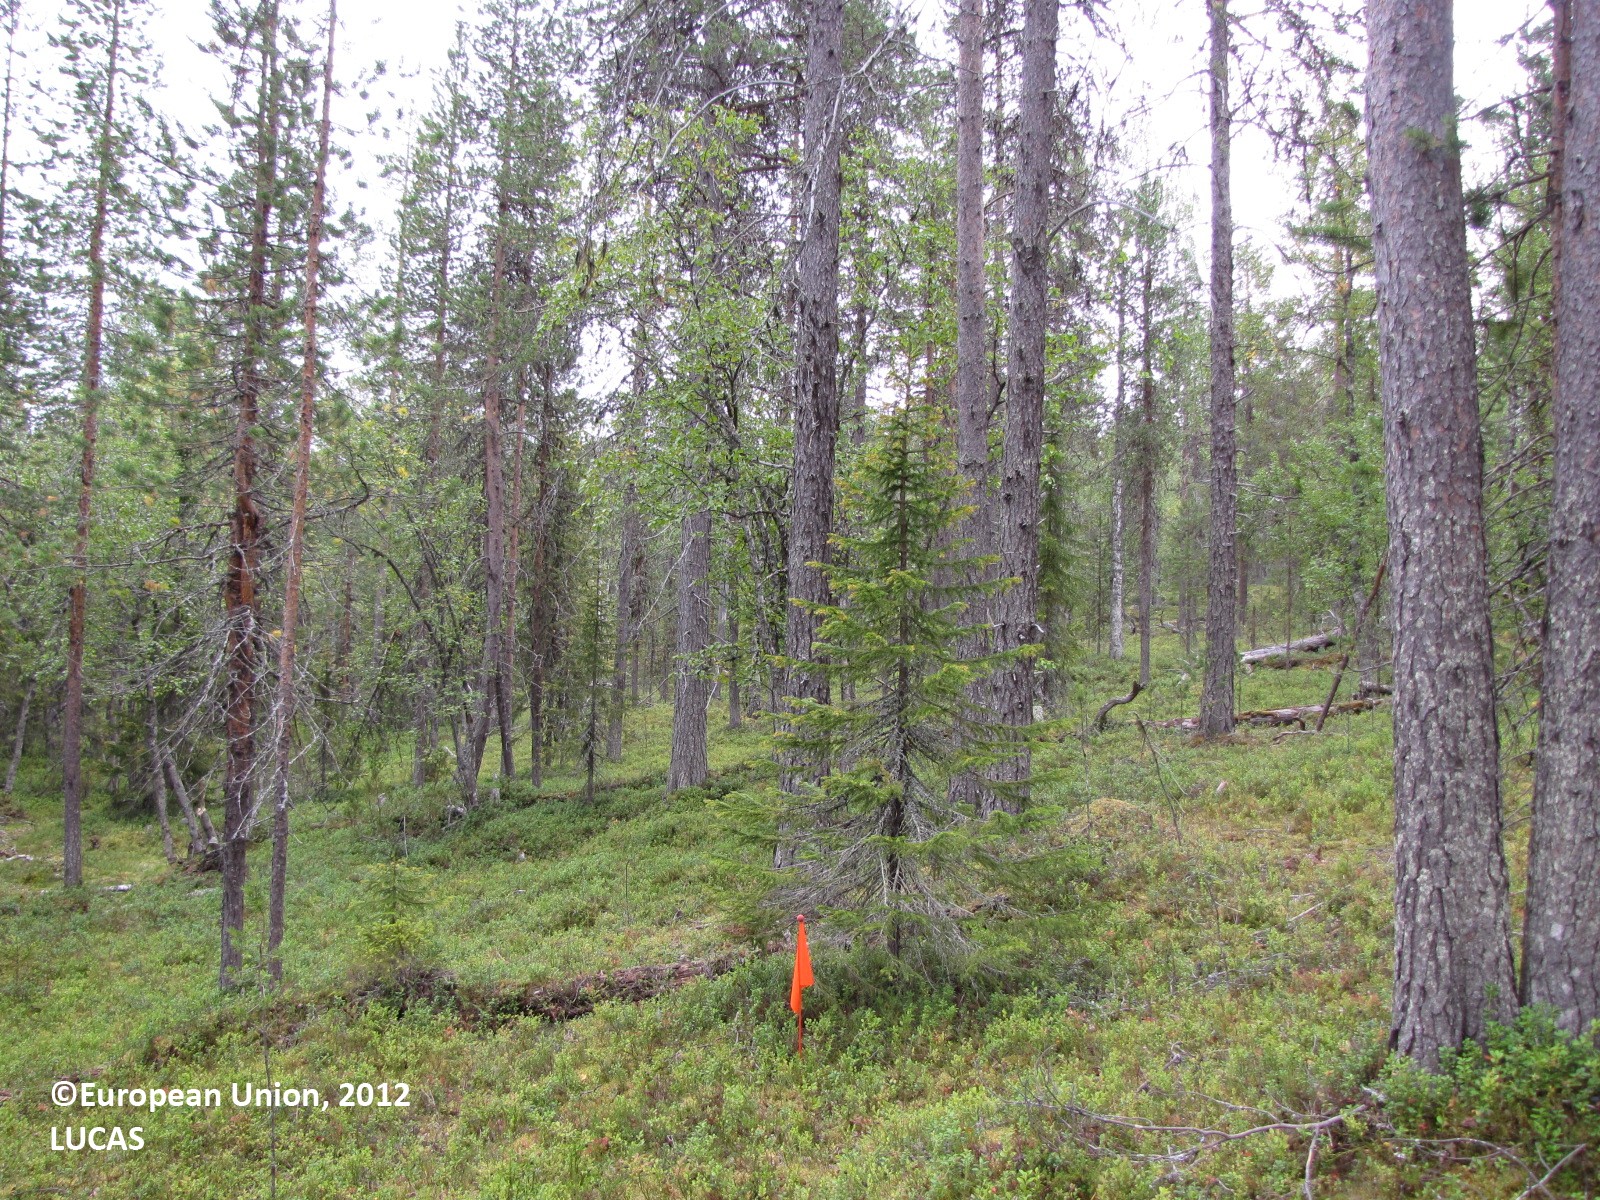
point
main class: Woodland
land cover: Pine dominated mixed woodland
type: boreal forest
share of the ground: 50 - 75 %
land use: Forestry
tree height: > 5 m
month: August
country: FI
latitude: 67.1262
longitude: 25.3363
